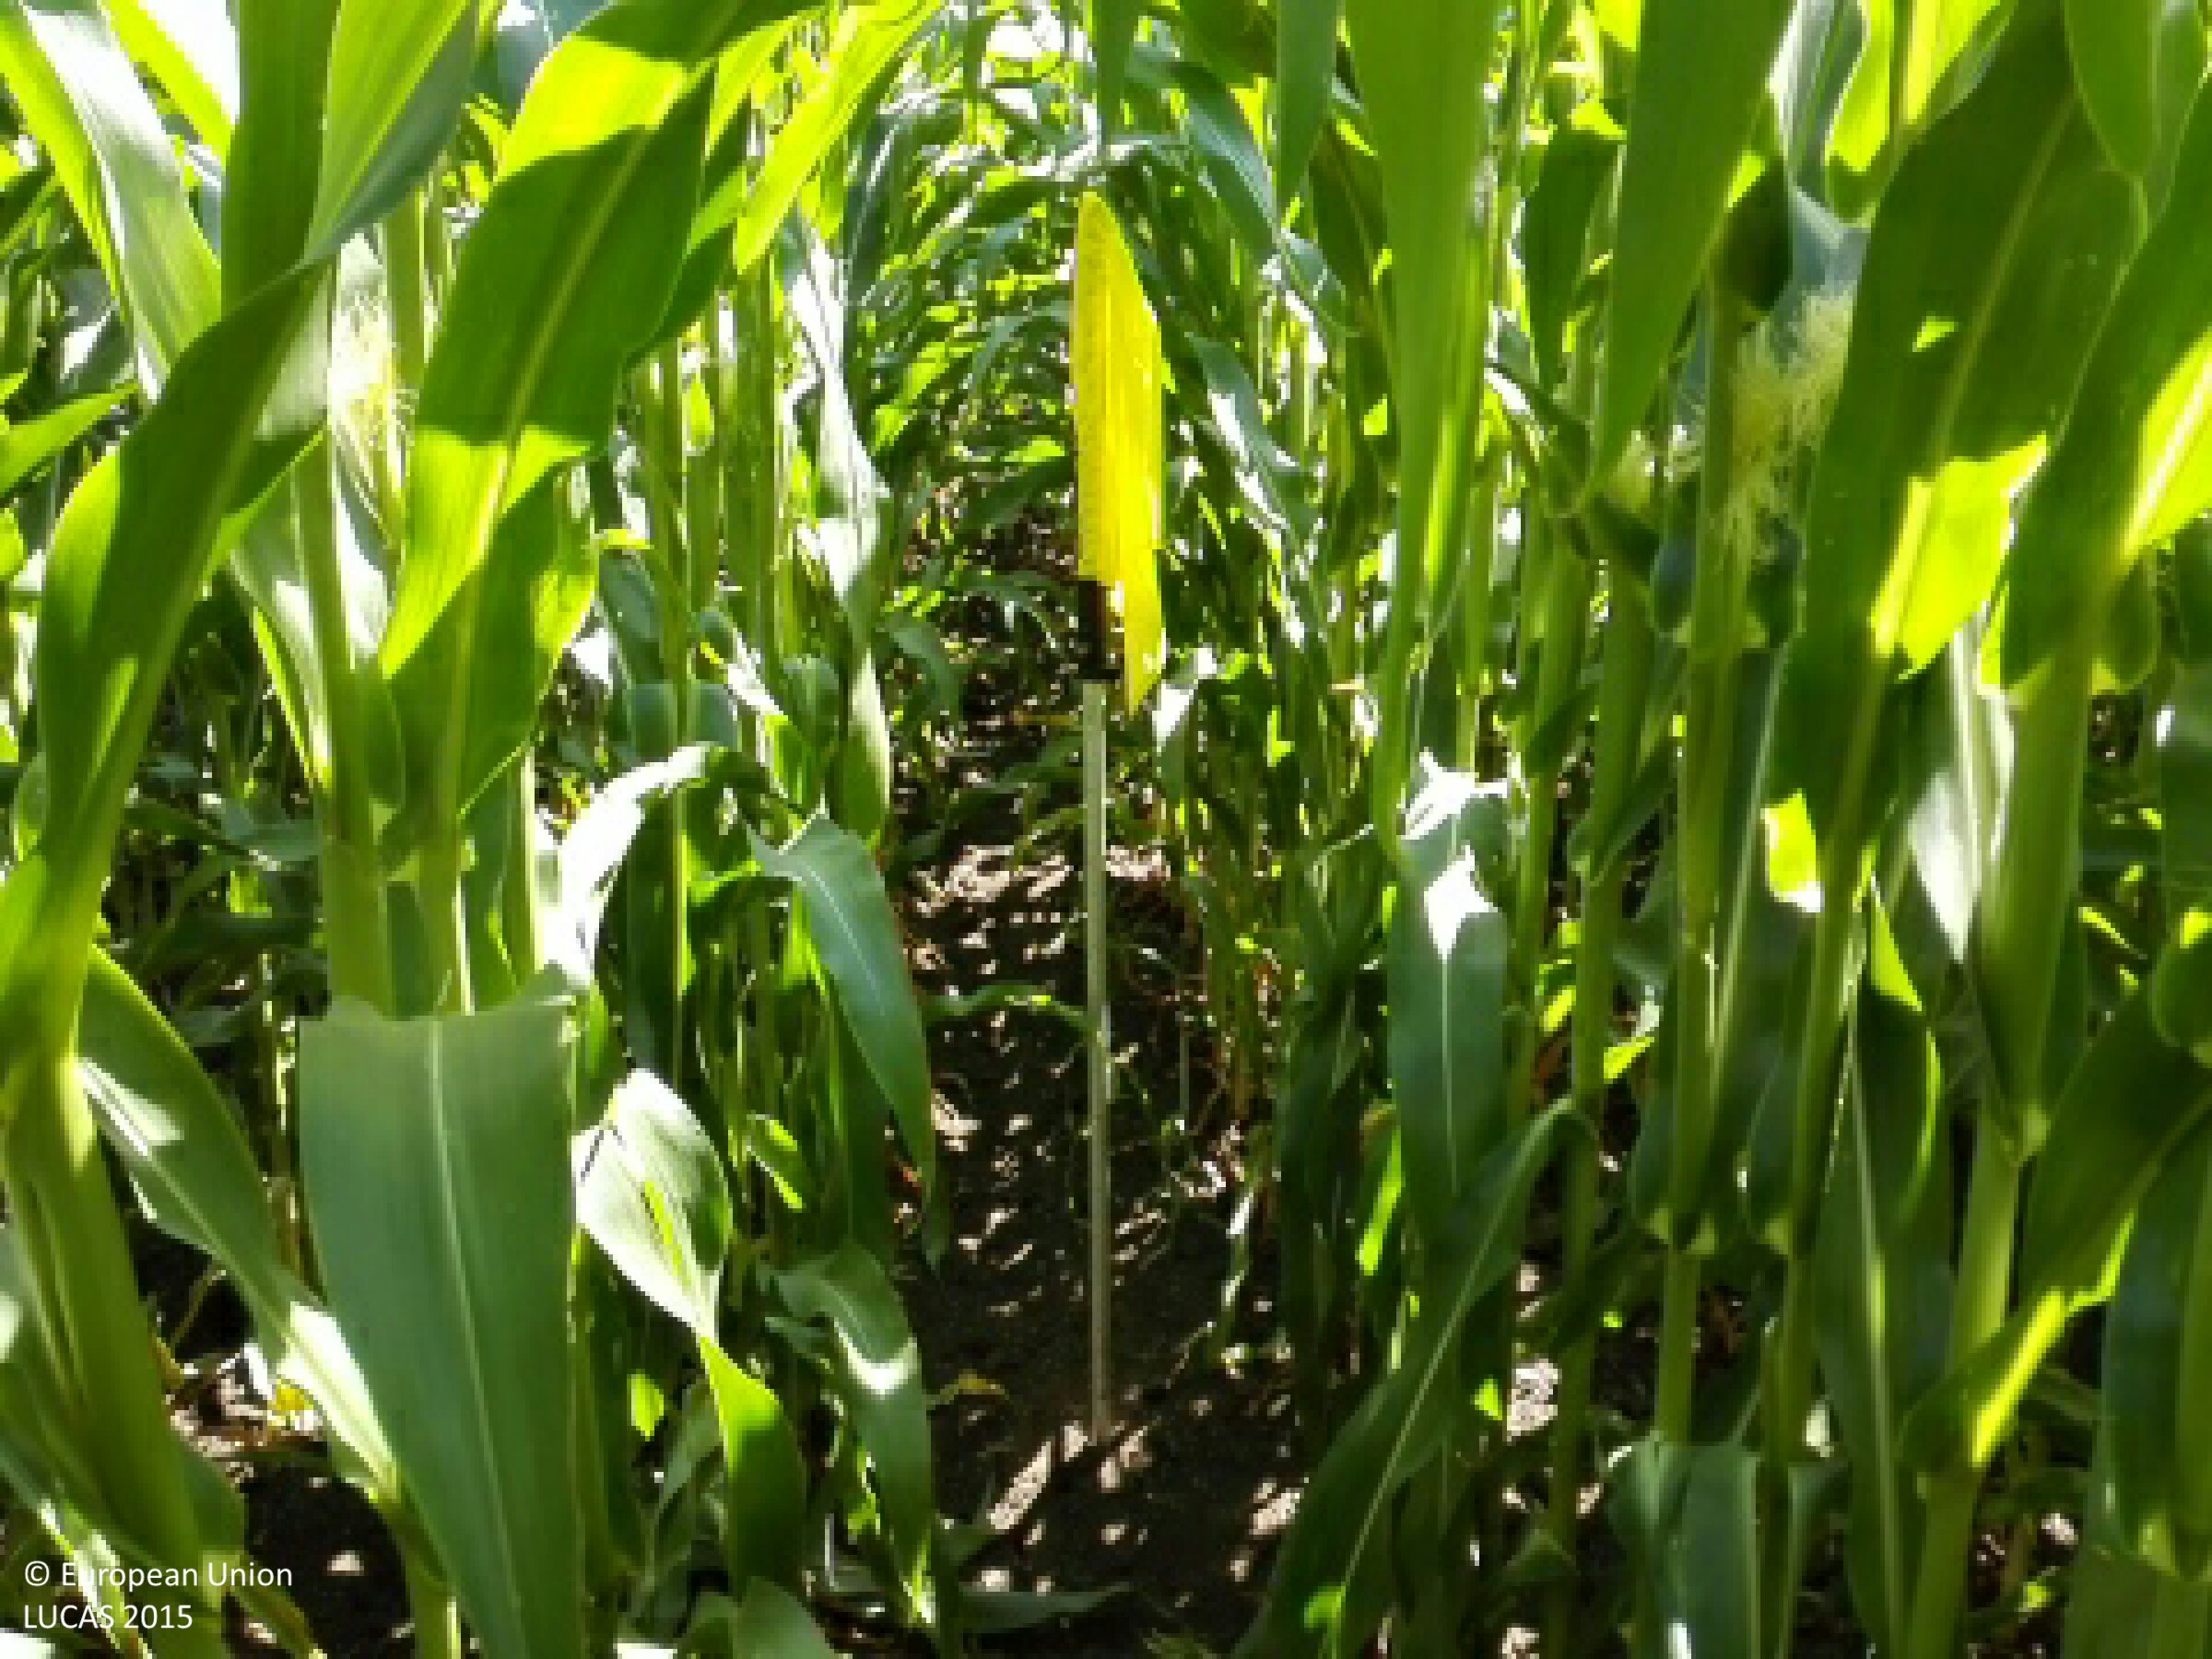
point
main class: Cropland
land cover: Maize
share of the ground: > 75 %
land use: Agriculture (excluding fallow land and kitchen gardens)
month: July
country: HU
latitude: 47.7400
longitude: 21.3914
